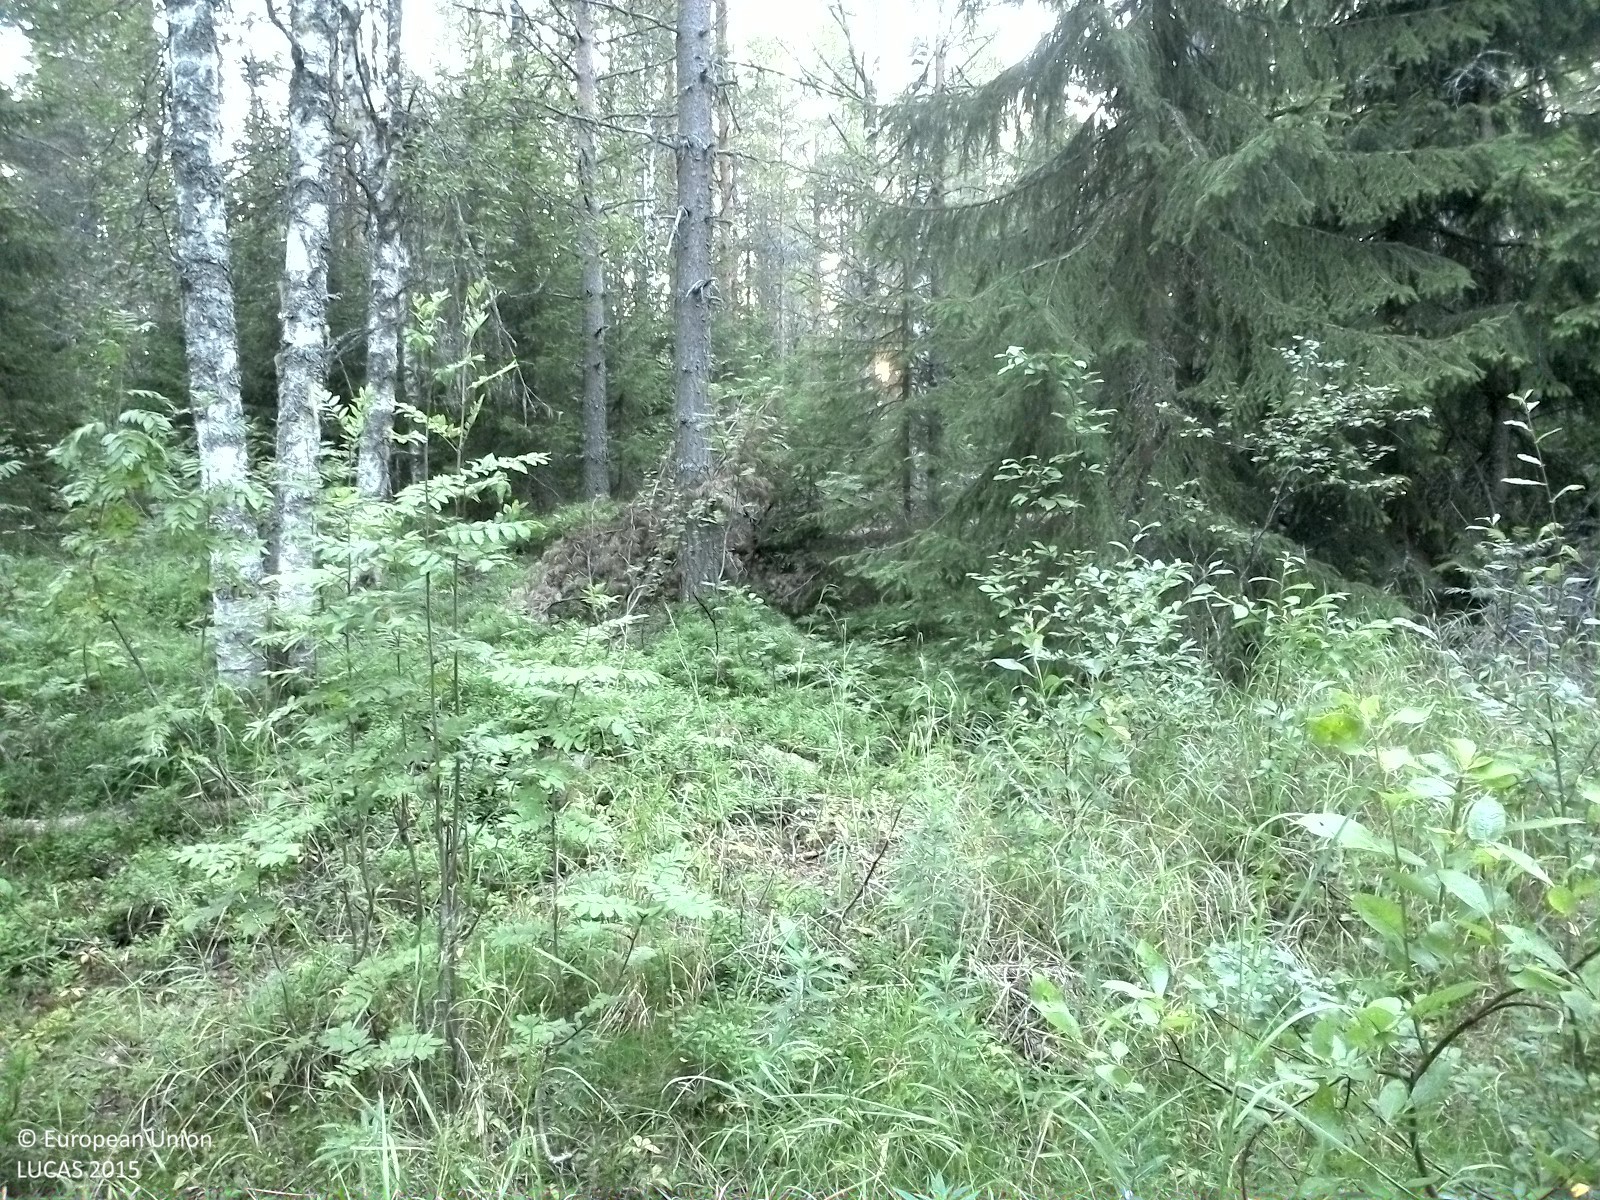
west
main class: Woodland
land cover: Other mixed woodland
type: boreal forest
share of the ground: 25 - 50 %
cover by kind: shrubs 55 %, coniferous forest trees 30 %, broadleaved forest trees 15 %
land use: Forestry
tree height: > 5 m
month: August
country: SE
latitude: 62.2040
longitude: 16.4202
